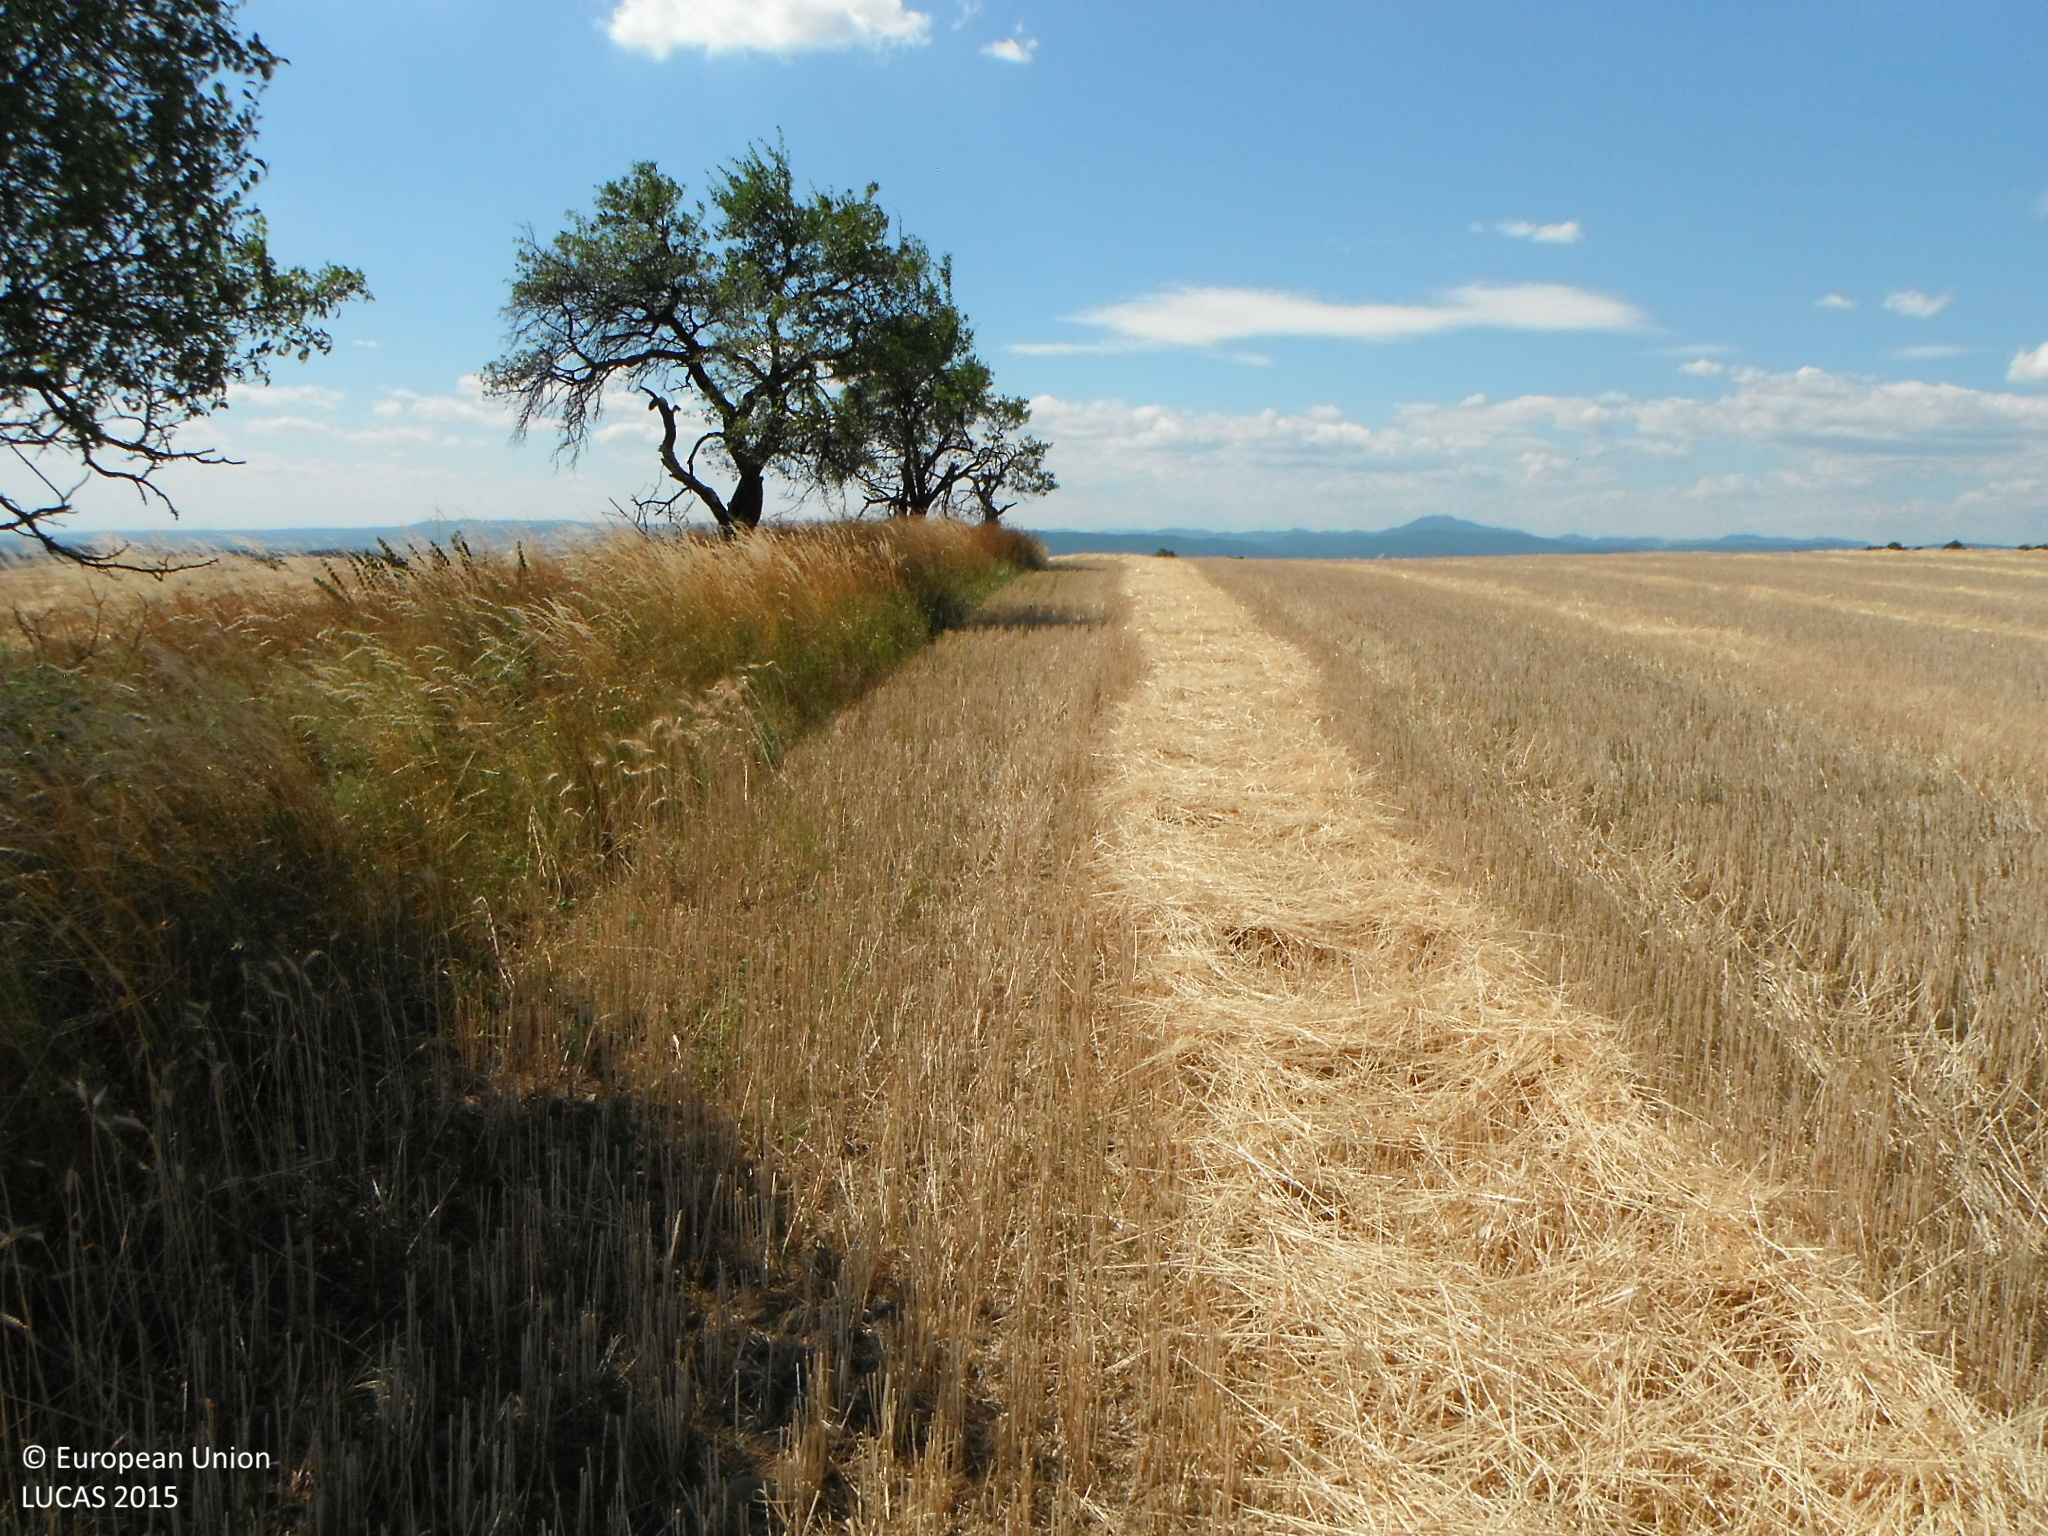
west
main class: Cropland
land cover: Common wheat
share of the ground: > 75 %
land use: Agriculture (excluding fallow land and kitchen gardens)
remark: Harvested field
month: July
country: SK
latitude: 48.3109
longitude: 19.1769
